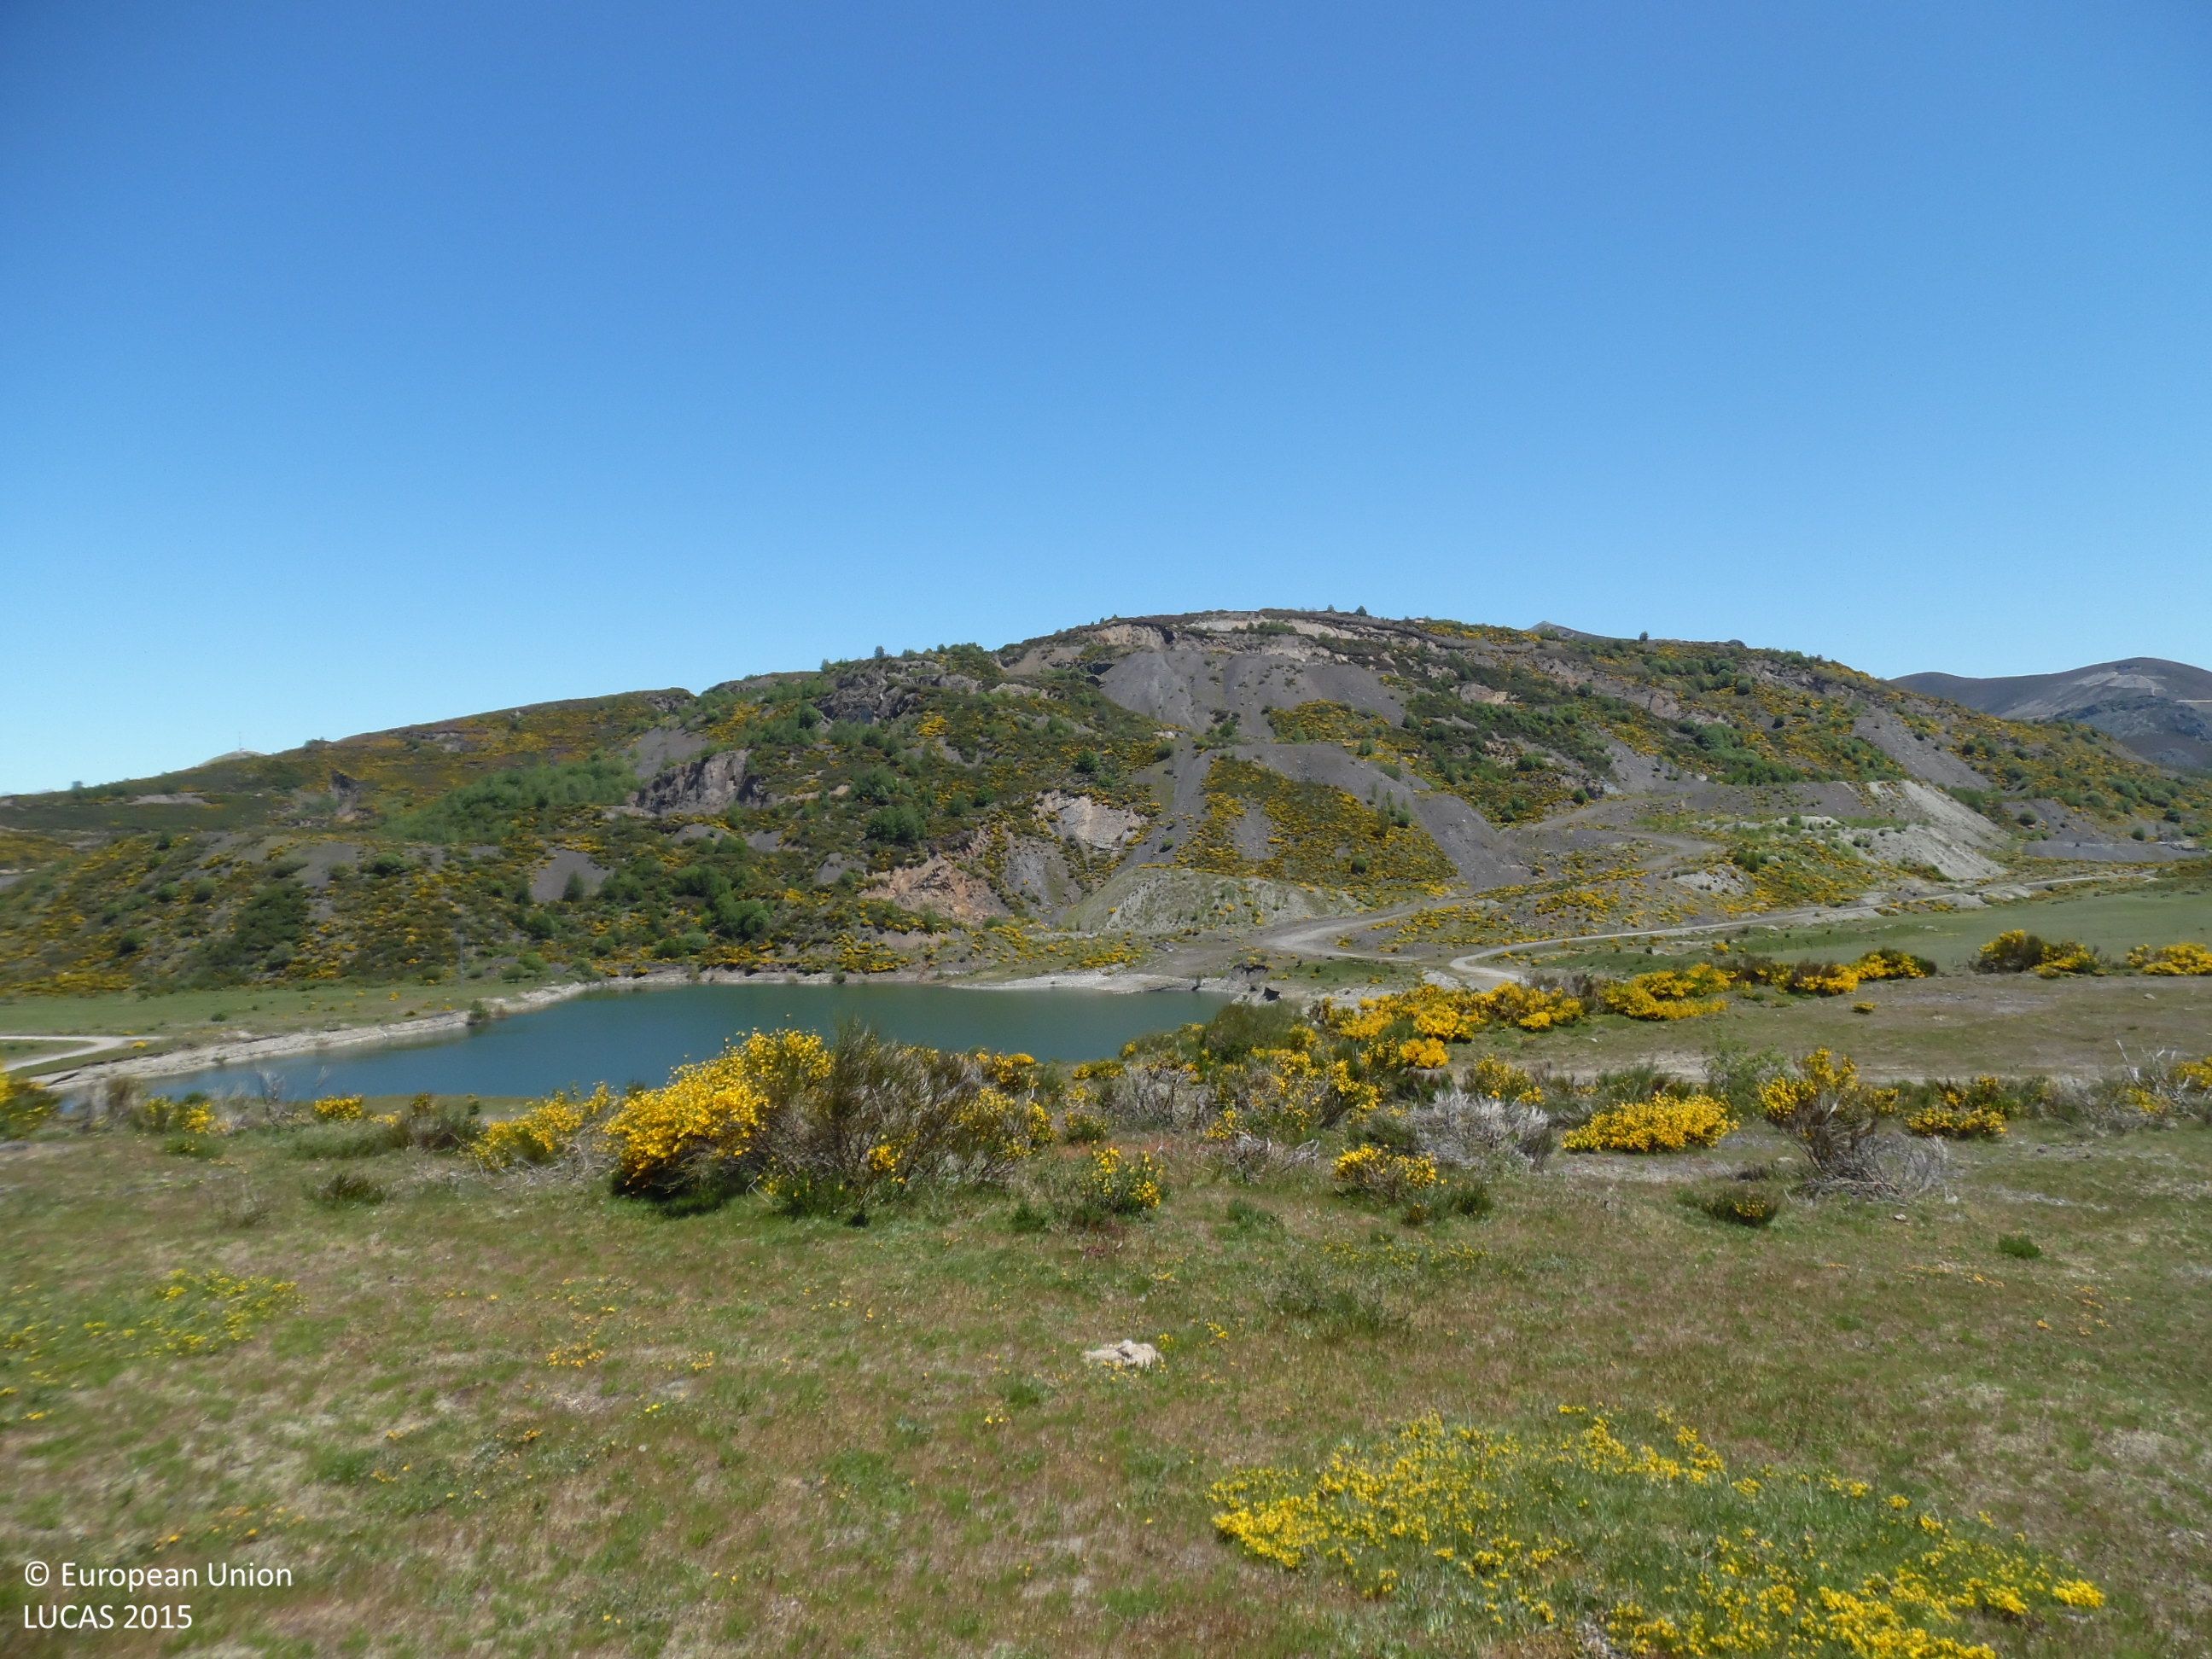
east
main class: Shrubland
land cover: Shrubland with sparse tree cover
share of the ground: 50 - 75 %
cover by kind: shrubs 95 %, broadleaved forest trees 5 %
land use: Other primary production
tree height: < 5 m
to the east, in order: Shrubland with sparse tree cover; Grass margins; Tracks; Shrubland without tree cover; Other bare soil; Shrubland with sparse tree cover; Other structural elements; Tracks; Other bare soil; Shrubland with sparse tree cover; Grassland with sparse tree/shrub cover; Inland fresh water bodies
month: May
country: ES
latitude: 42.9203
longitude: -6.2005
